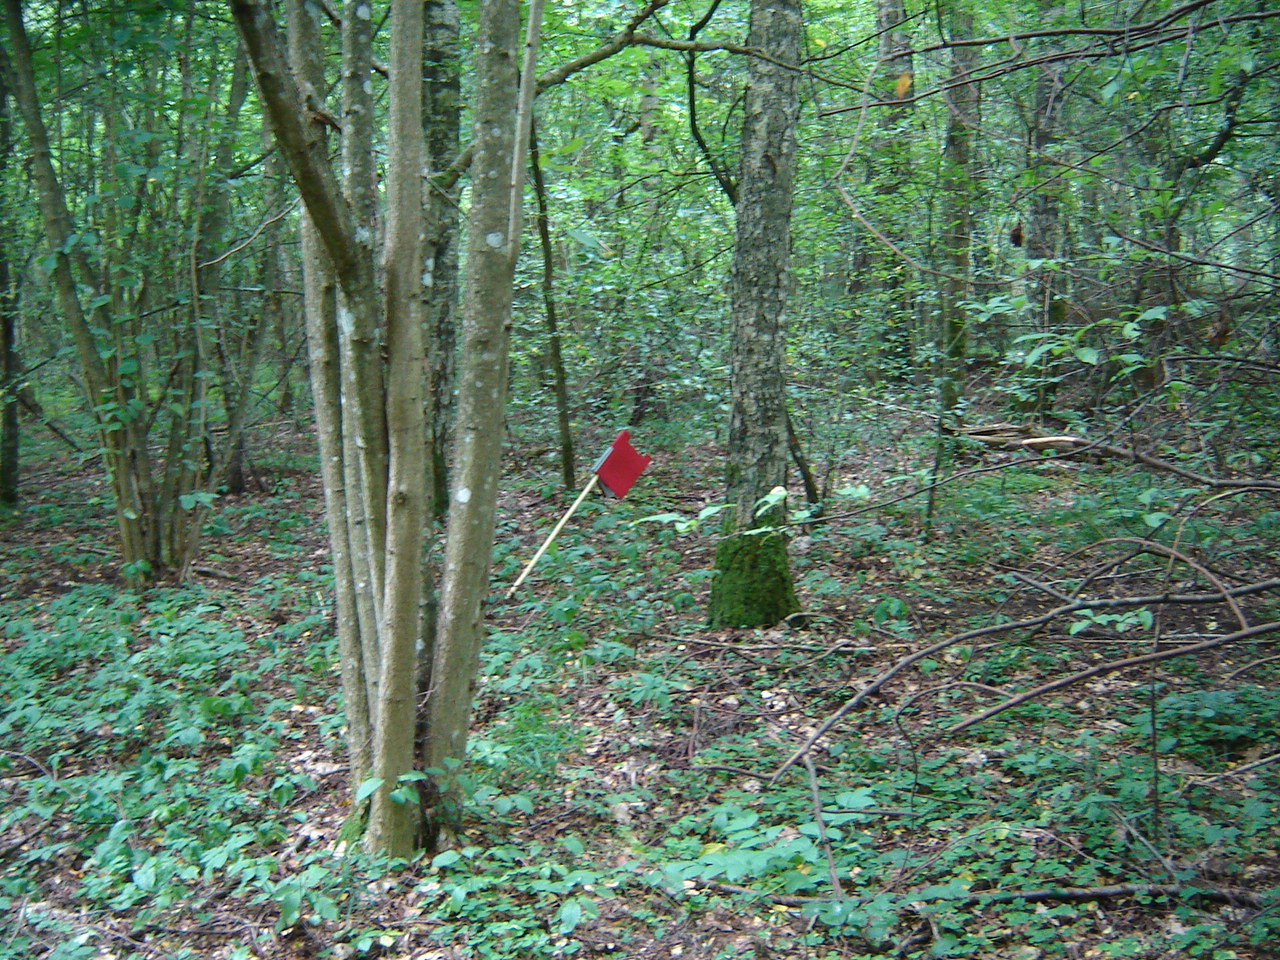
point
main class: Woodland
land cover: Other mixed woodland
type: hemiboreal forest and nemoral coniferous forest and mixed broadleaved-coniferous forest
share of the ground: > 75 %
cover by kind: broadleaved forest trees 50 %, coniferous forest trees 45 %, herbaceous plants 5 %
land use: Forestry
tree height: > 5 m
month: July
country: LT
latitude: 55.3129
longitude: 25.0342
